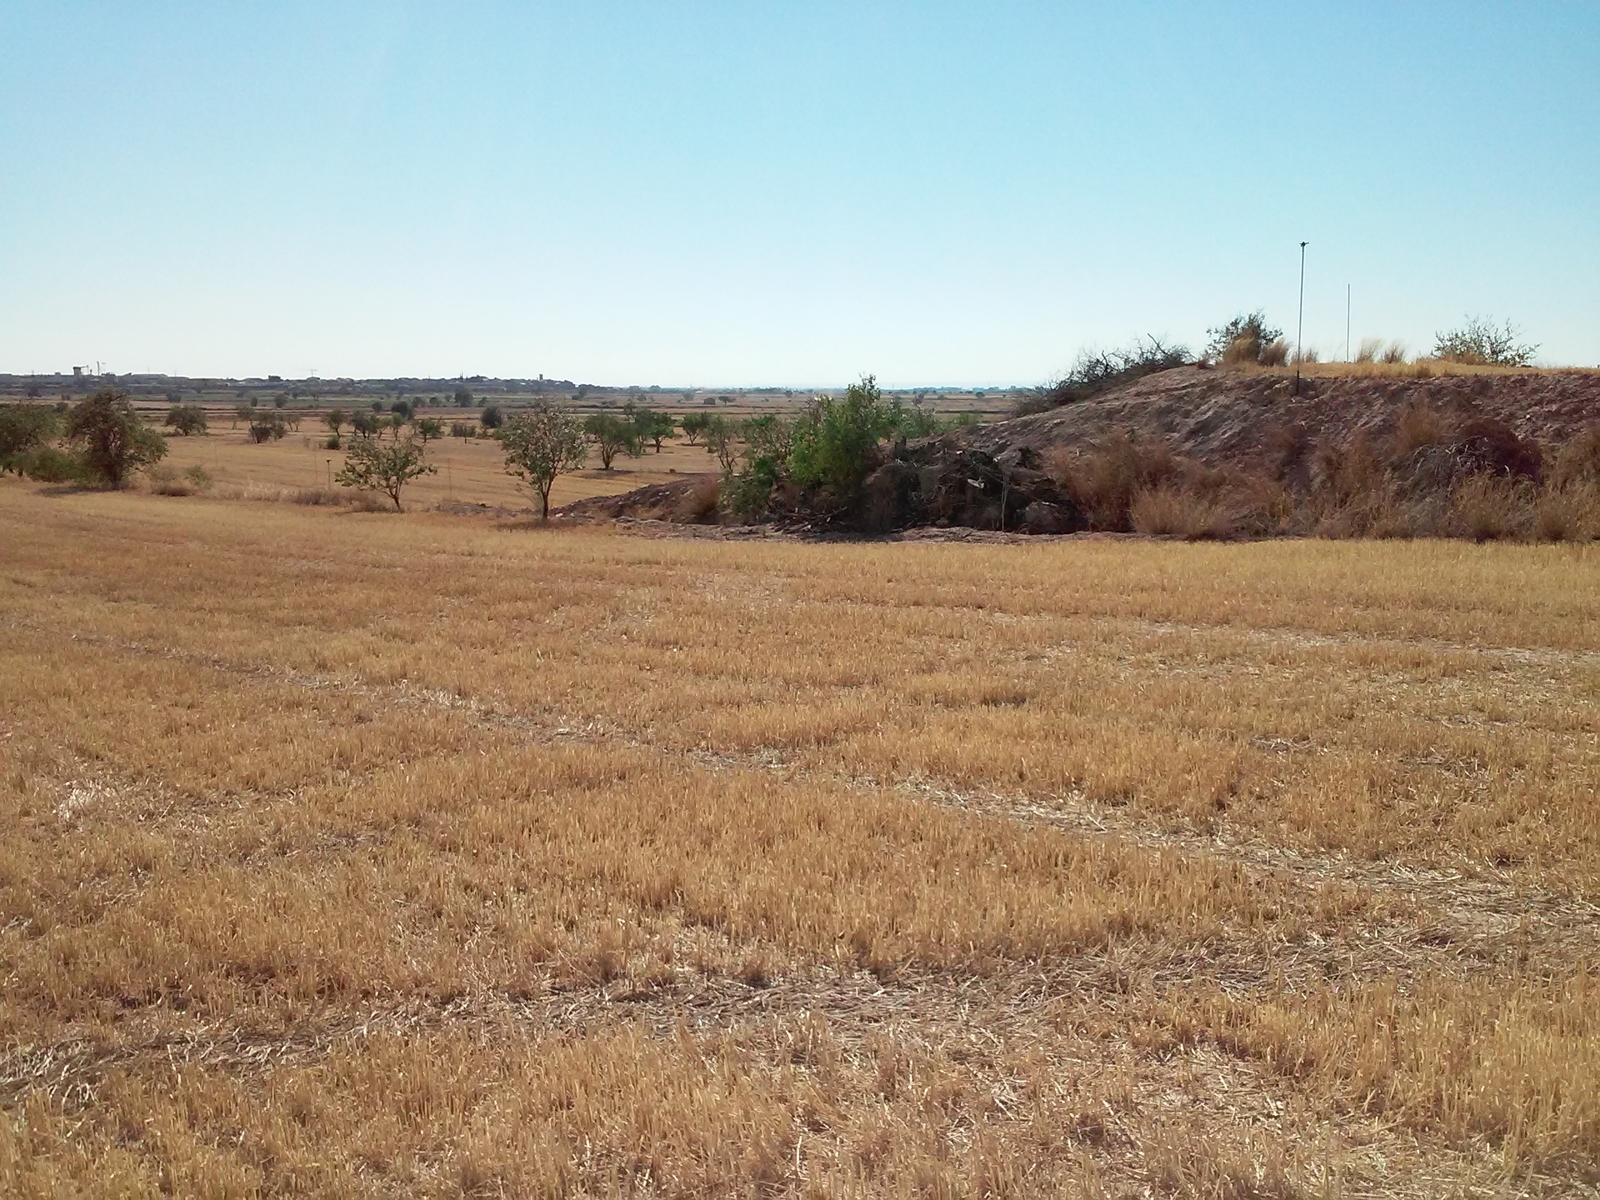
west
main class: Cropland
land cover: Barley
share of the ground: < 10 %
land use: Agriculture (excluding fallow land and kitchen gardens)
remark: Harvested field
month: July
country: ES
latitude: 41.6634
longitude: 1.1142
